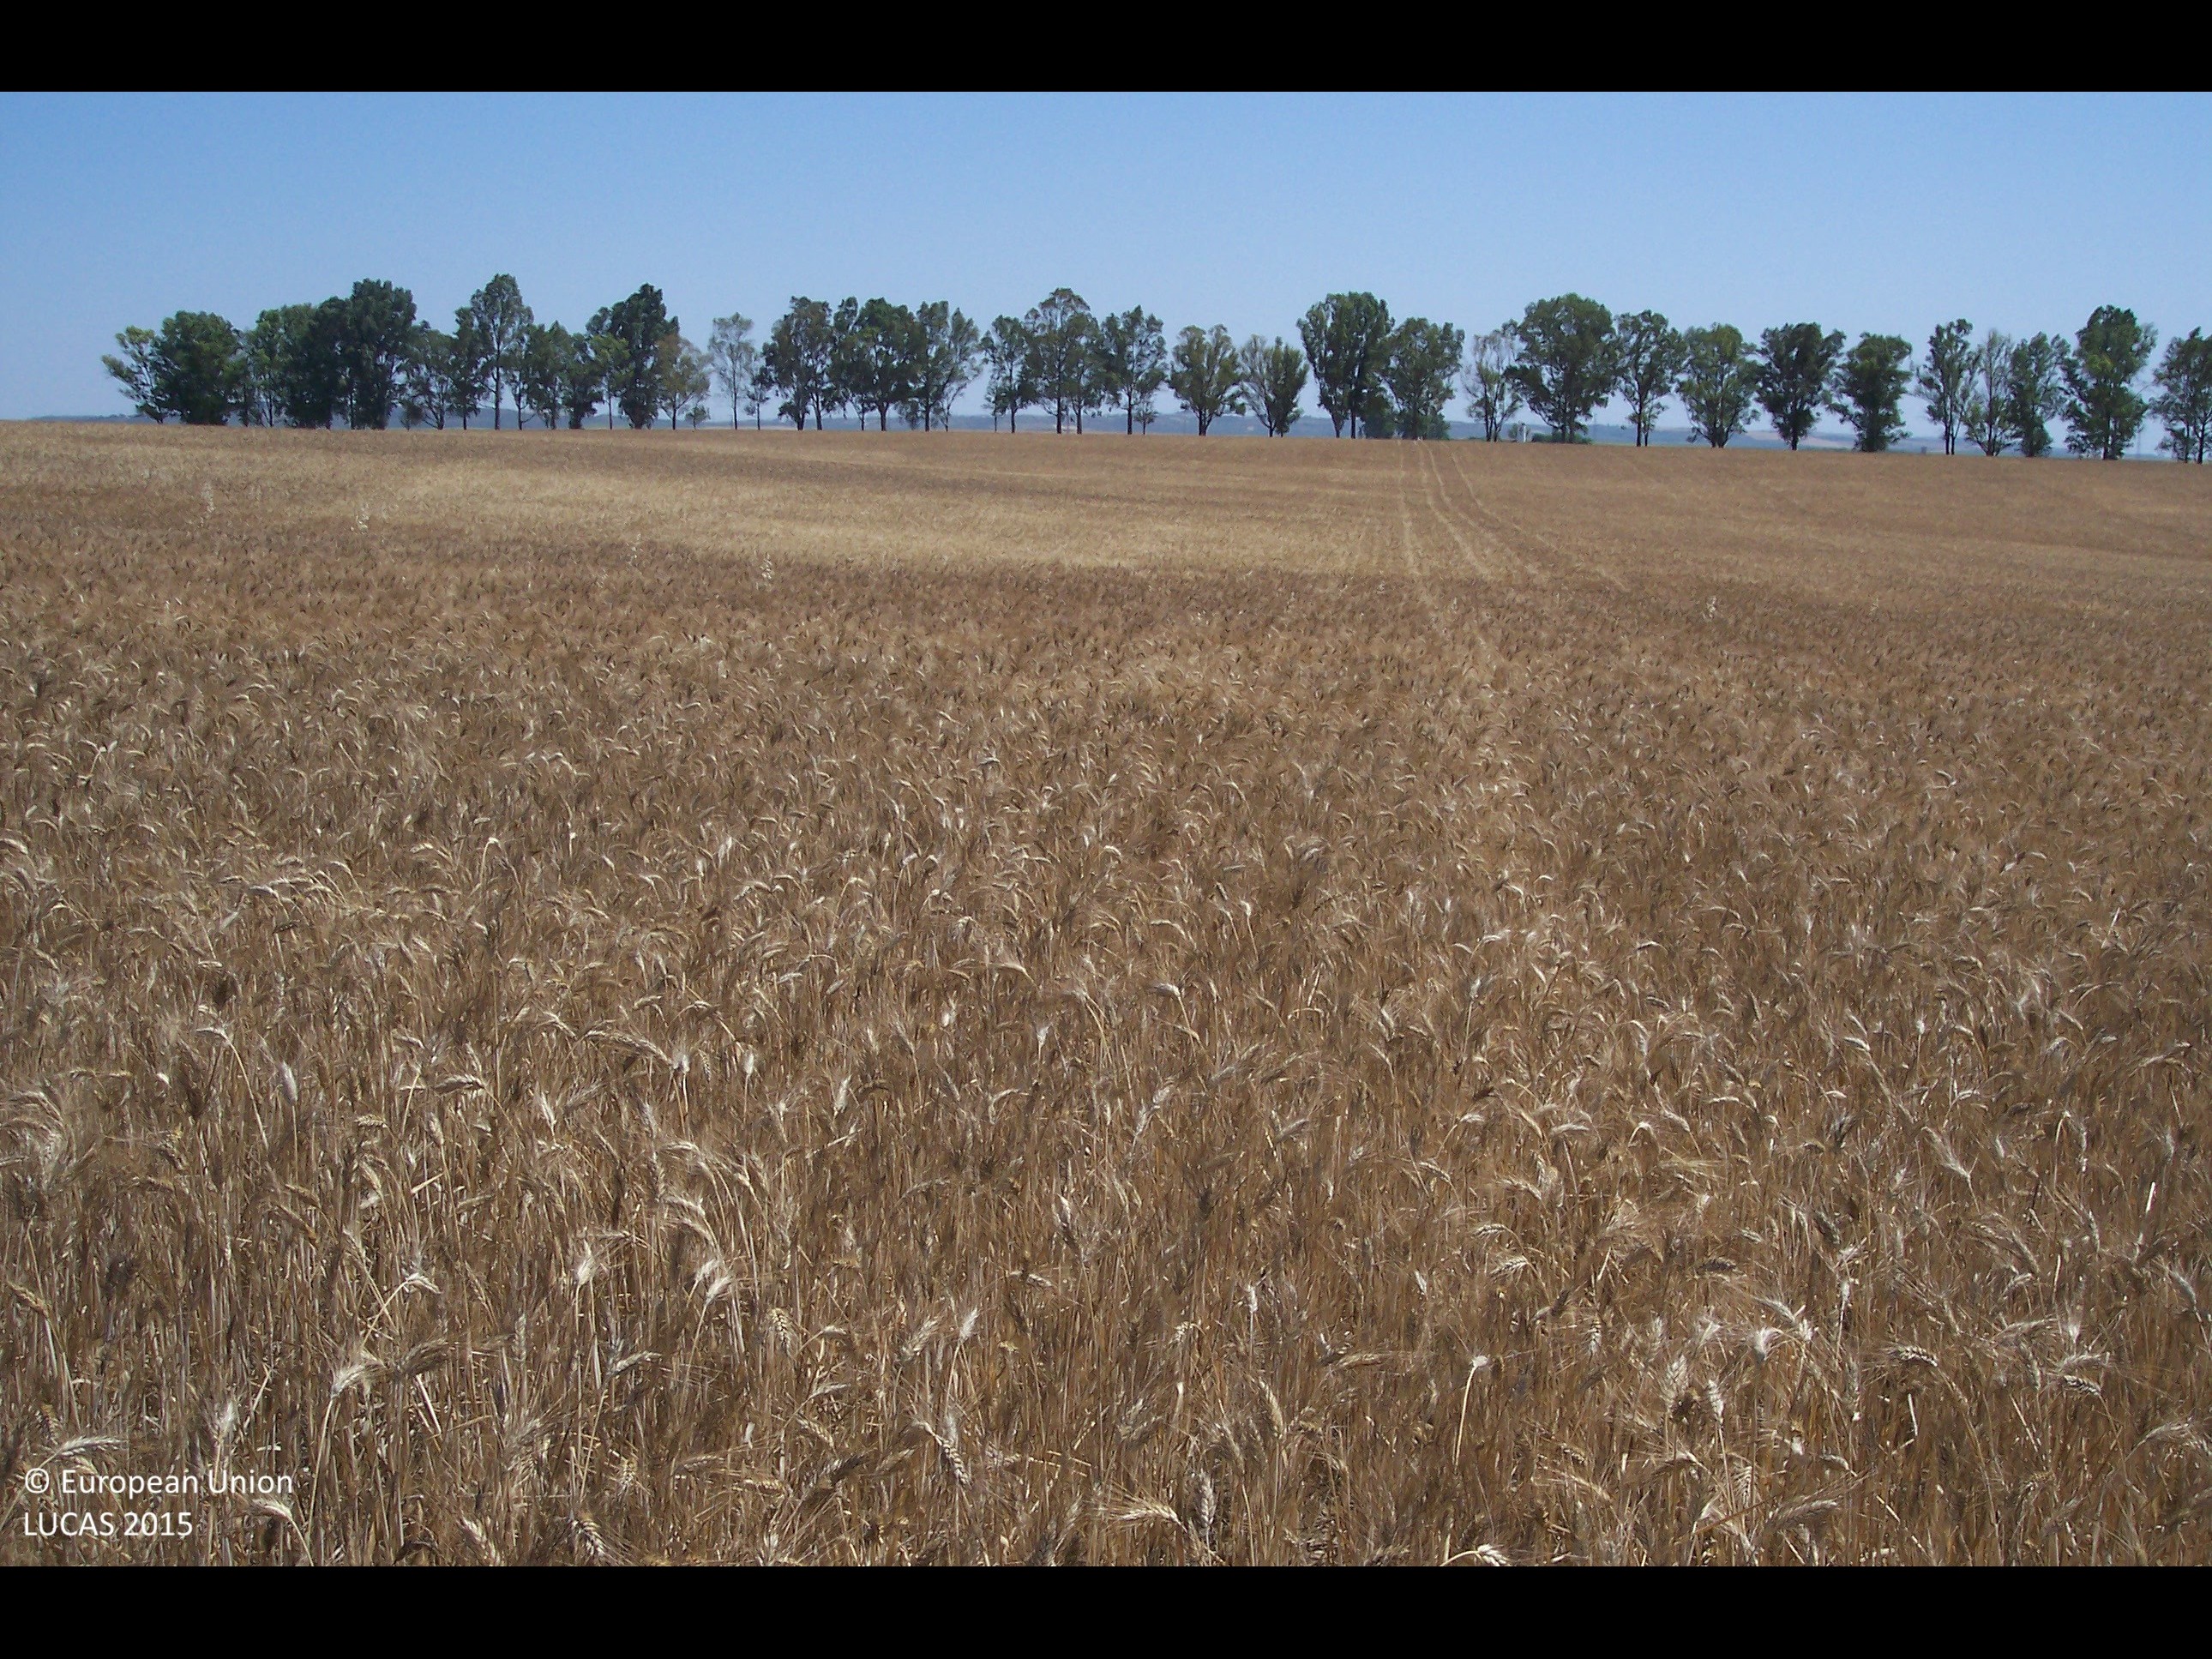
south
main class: Cropland
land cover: Durum wheat
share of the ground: > 75 %
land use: Agriculture (excluding fallow land and kitchen gardens)
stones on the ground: > 50 %
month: June
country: ES
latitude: 37.5150
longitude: -6.1739
